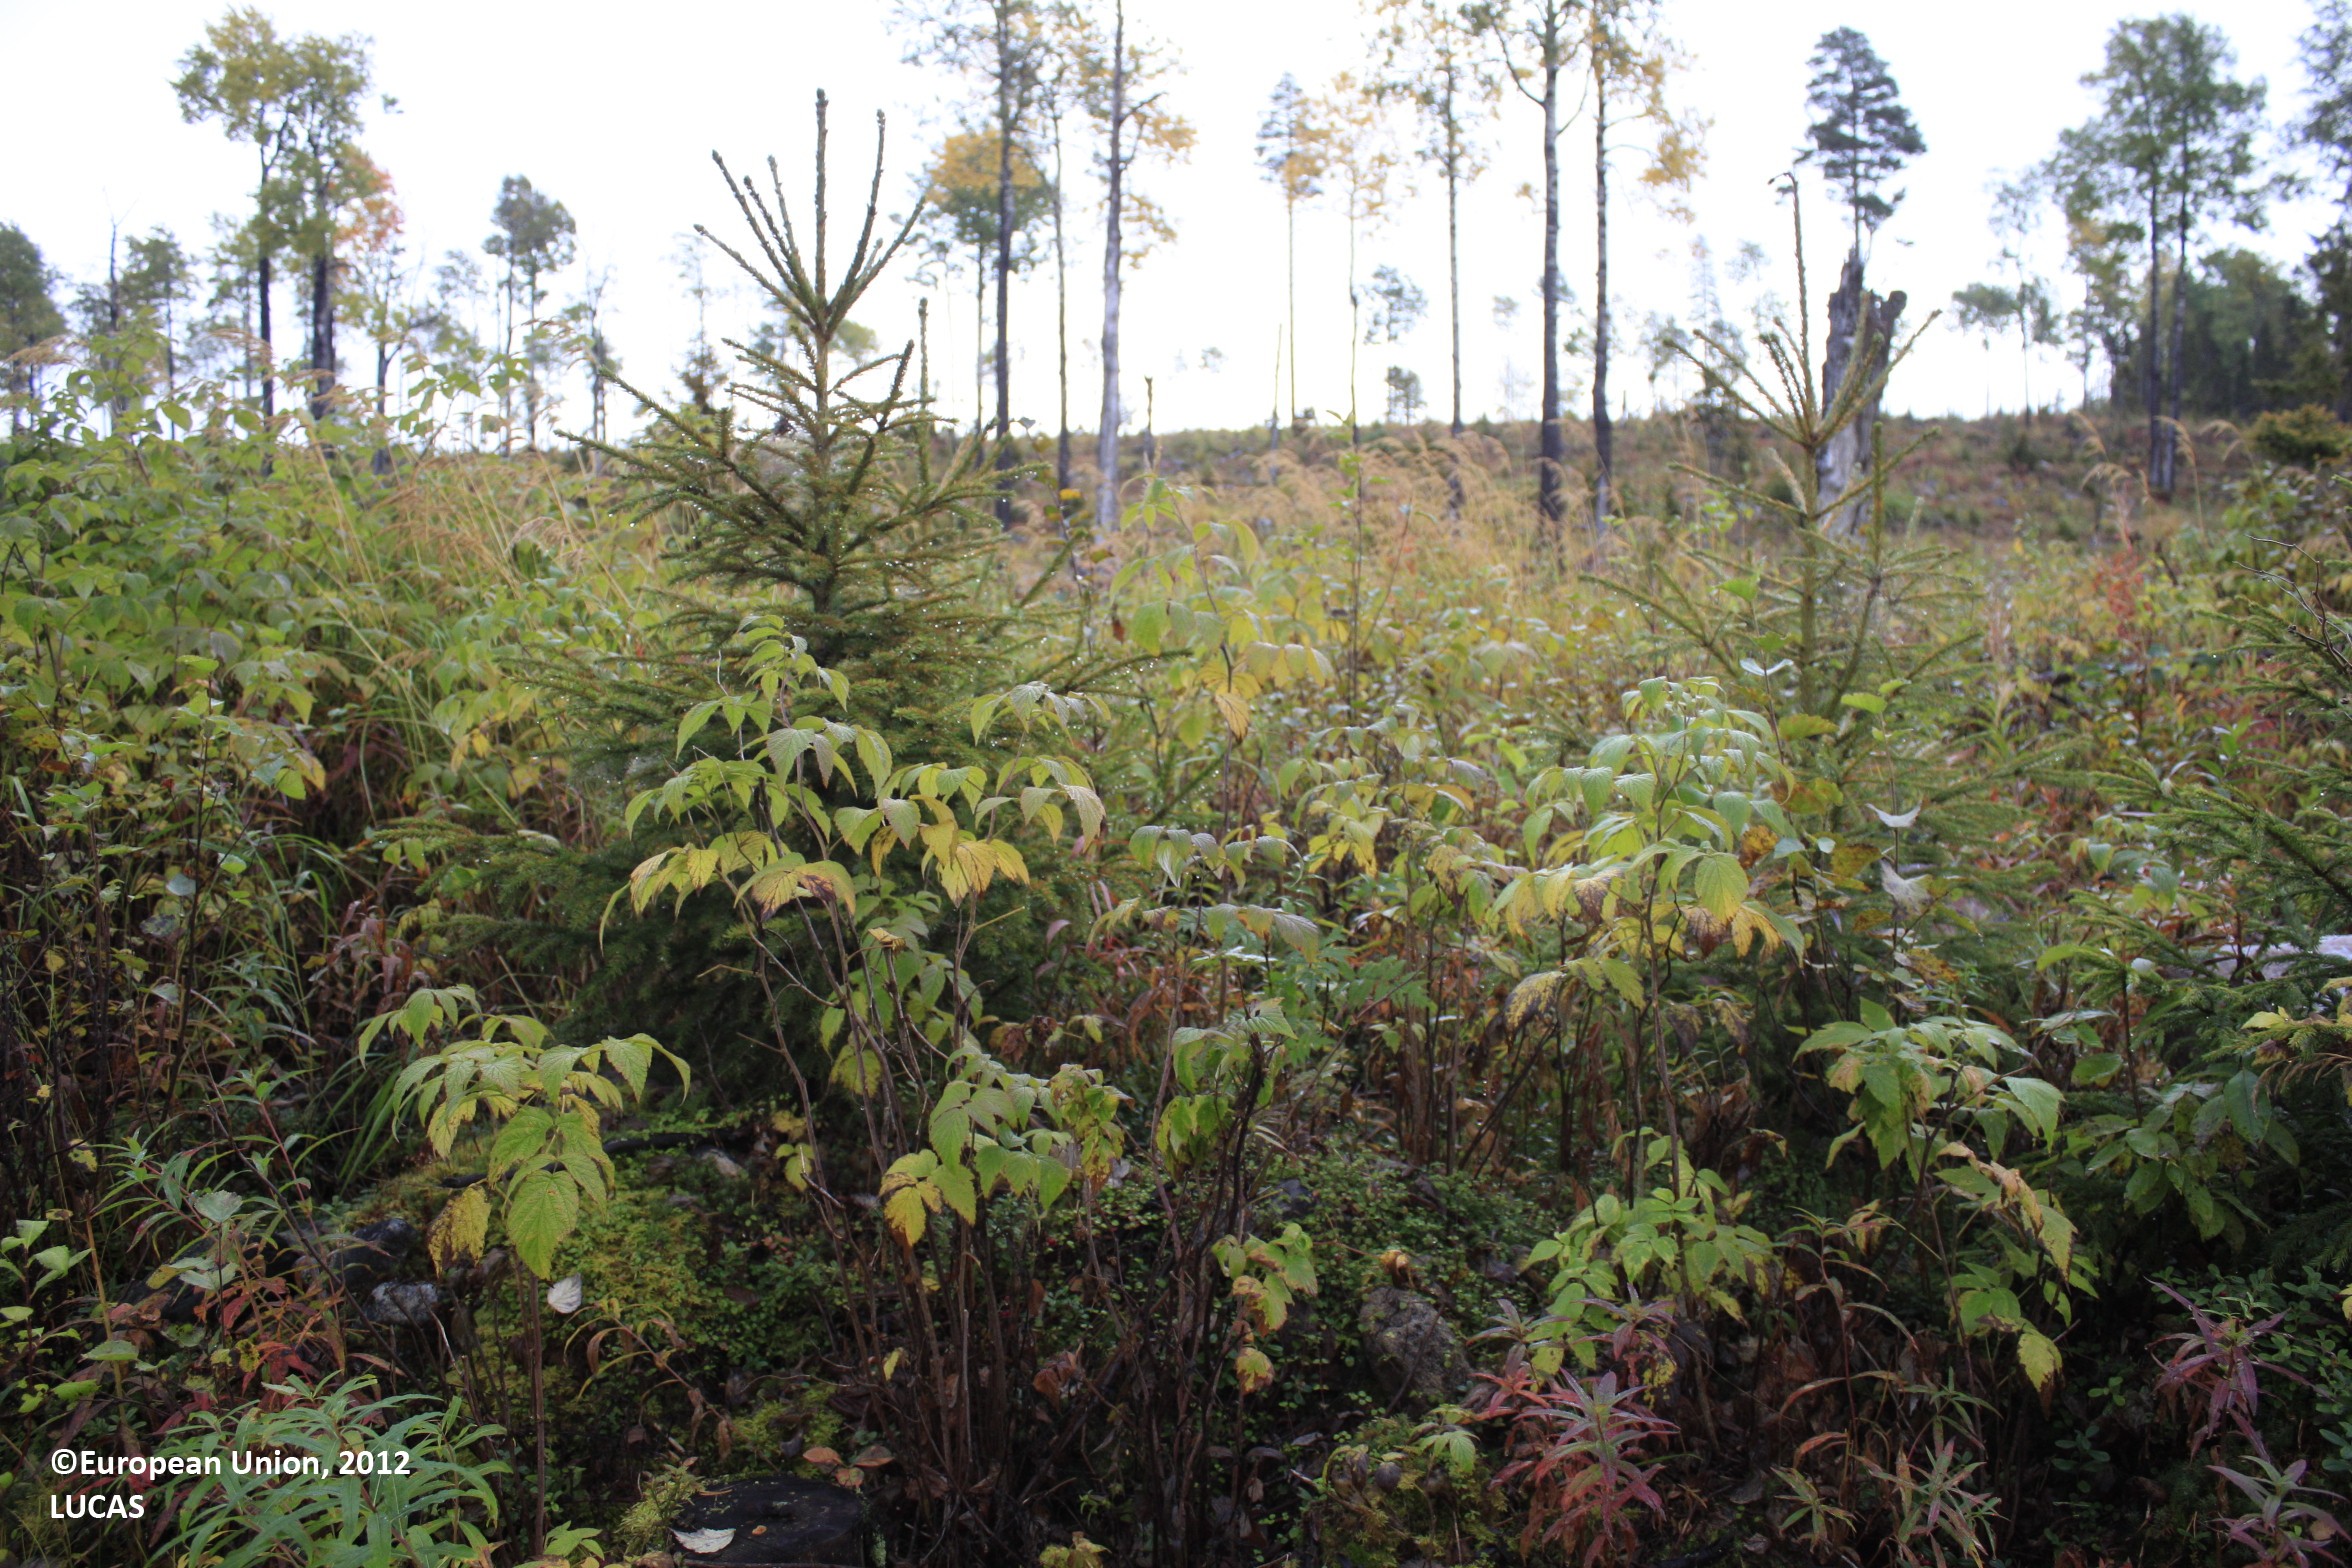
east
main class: Shrubland
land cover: Shrubland with sparse tree cover
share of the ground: > 75 %
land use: Forestry
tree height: < 5 m
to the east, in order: Shrubland with sparse tree cover
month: September
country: FI
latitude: 65.6928
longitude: 27.4331
